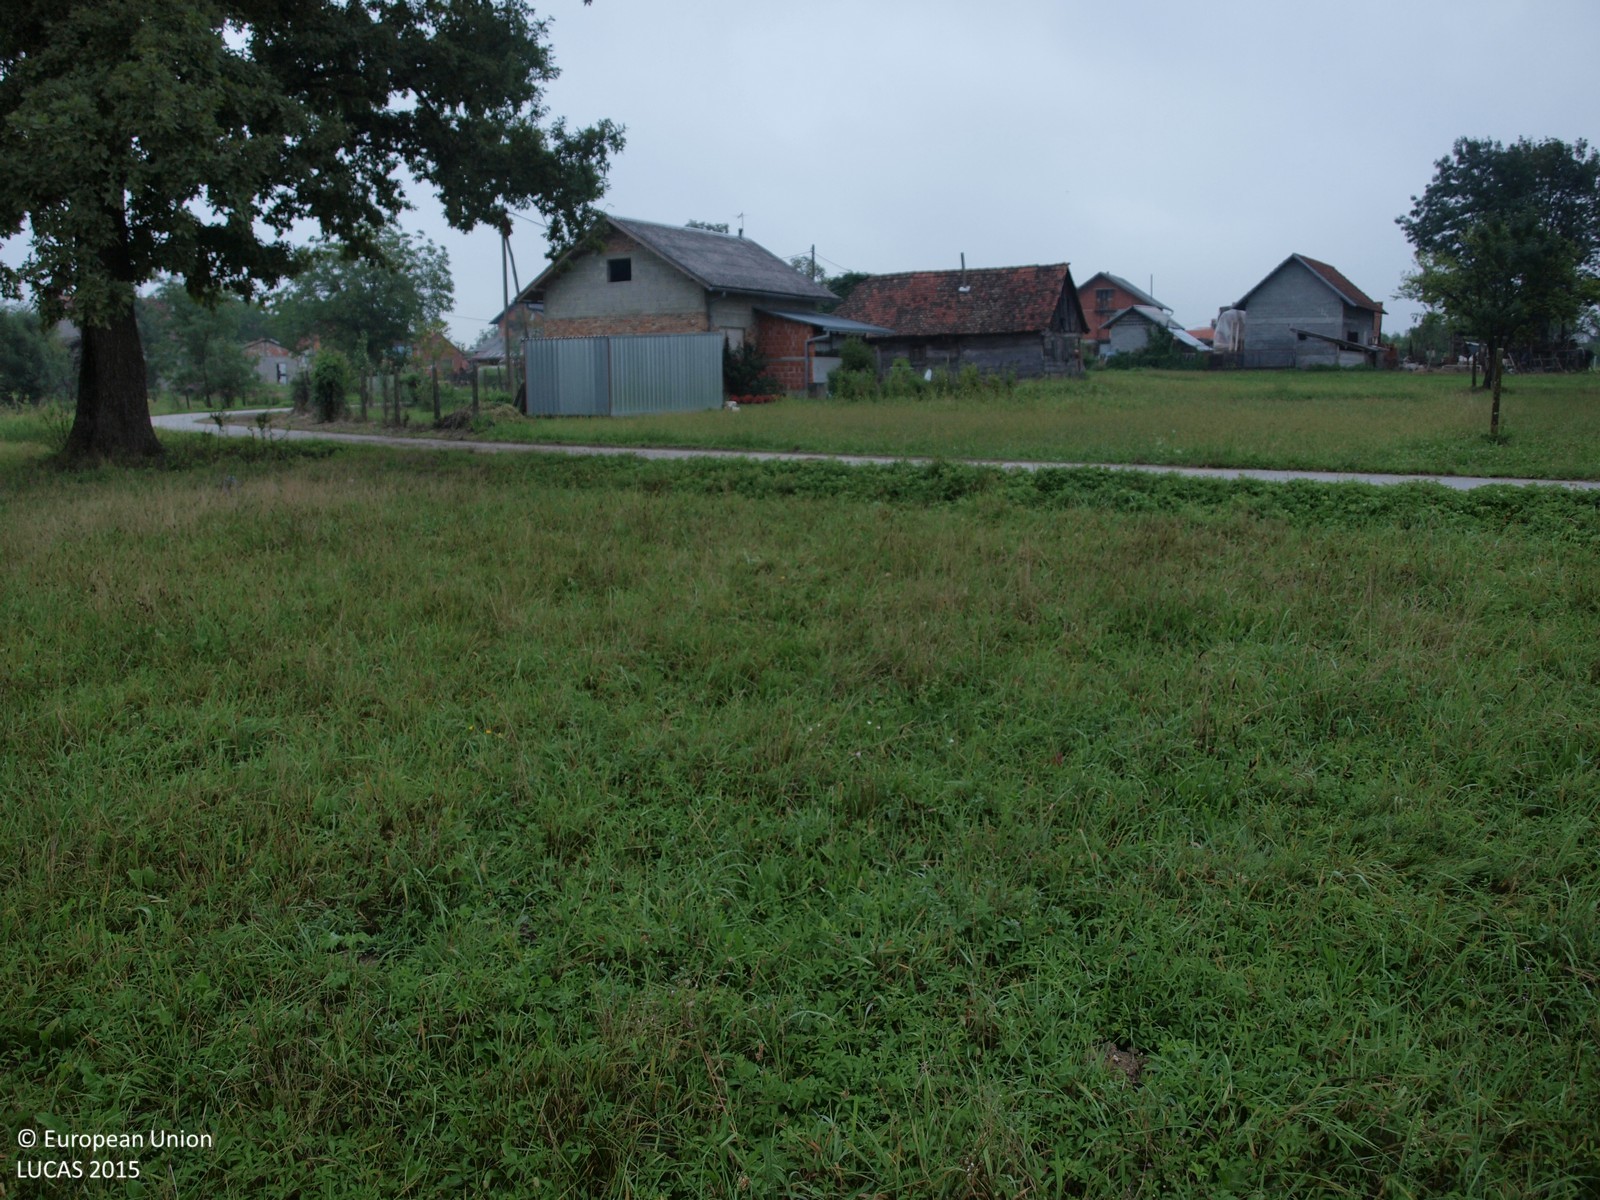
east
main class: Grassland
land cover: Grassland without tree/shrub cover
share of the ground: > 75 %
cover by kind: herbaceous plants 100 %
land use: Agriculture (excluding fallow land and kitchen gardens)
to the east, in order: Grassland without tree/shrub cover; Paved roads, cycling and walking lanes; Artificial constructions in urban areas
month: August
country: HR
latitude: 45.8047
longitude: 16.2907
